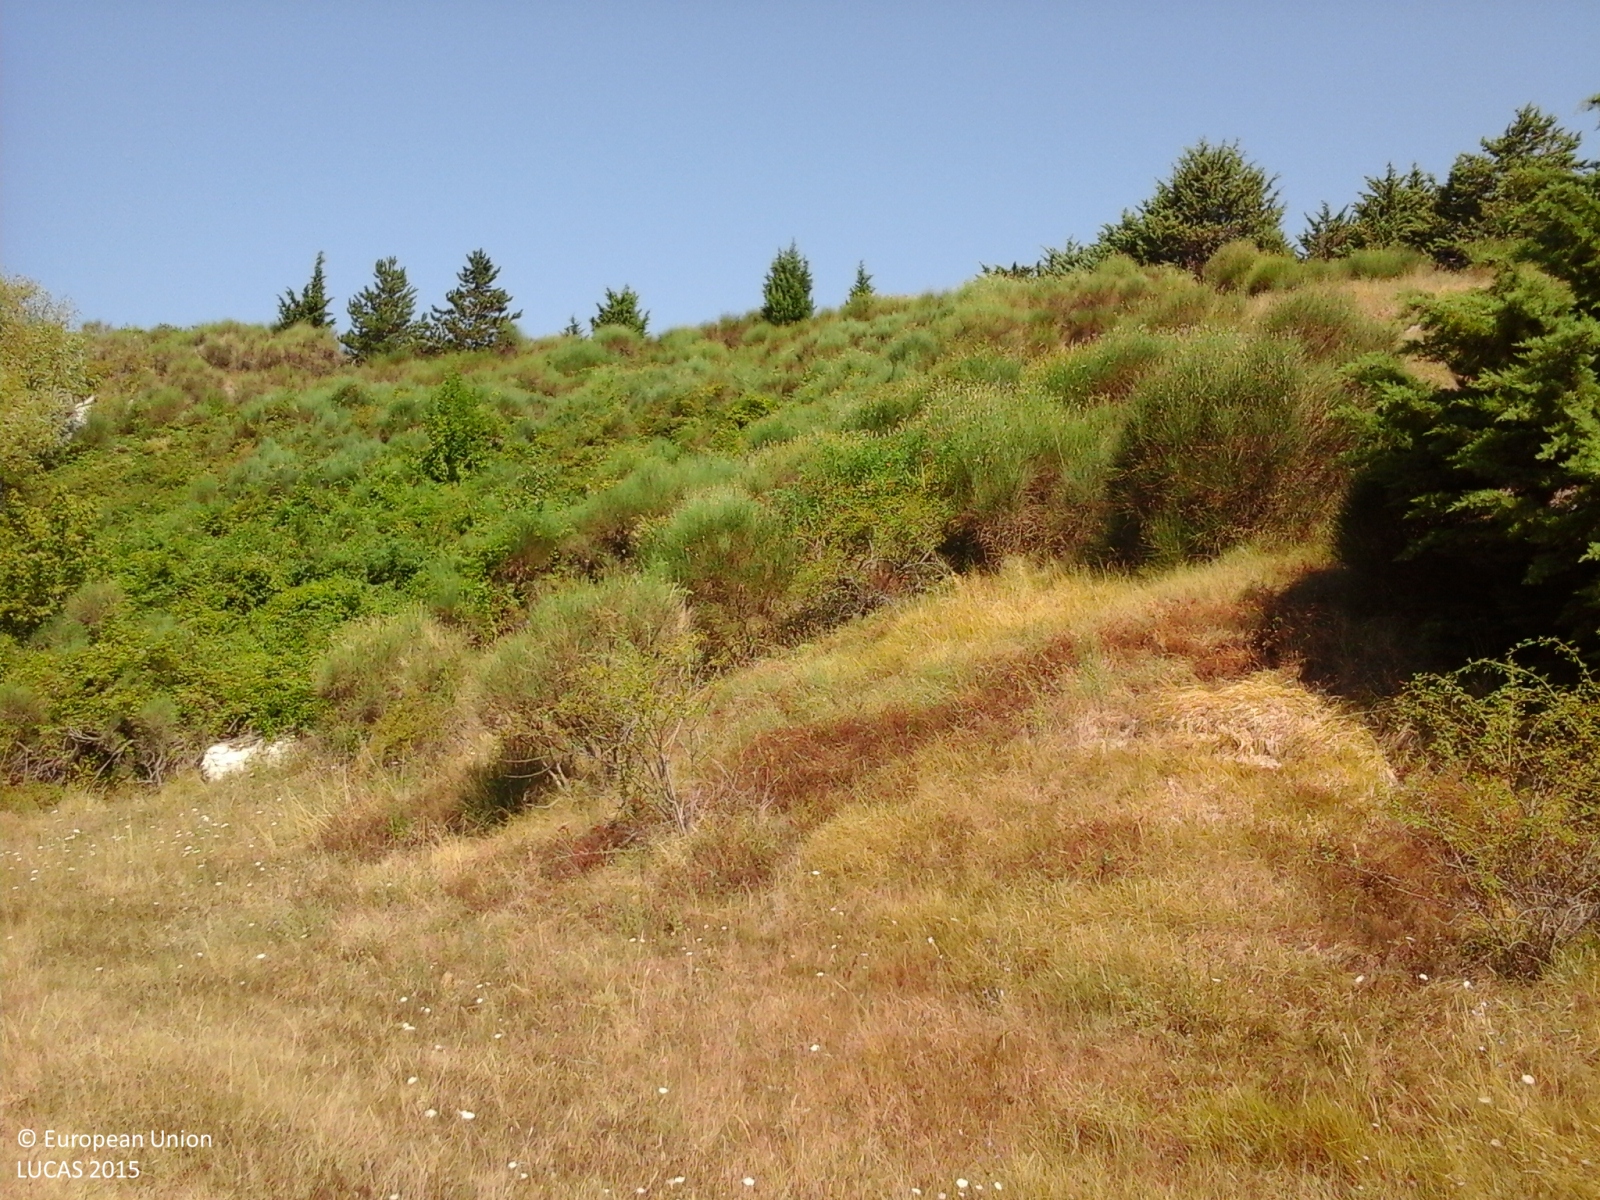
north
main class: Grassland
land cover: Grassland with sparse tree/shrub cover
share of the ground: > 75 %
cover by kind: herbaceous plants 85 %, shrubs 10 %, broadleaved forest trees 5 %
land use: Semi-natural and natural areas not in use
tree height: < 5 m
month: August
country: IT
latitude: 43.6692
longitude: 12.5608
